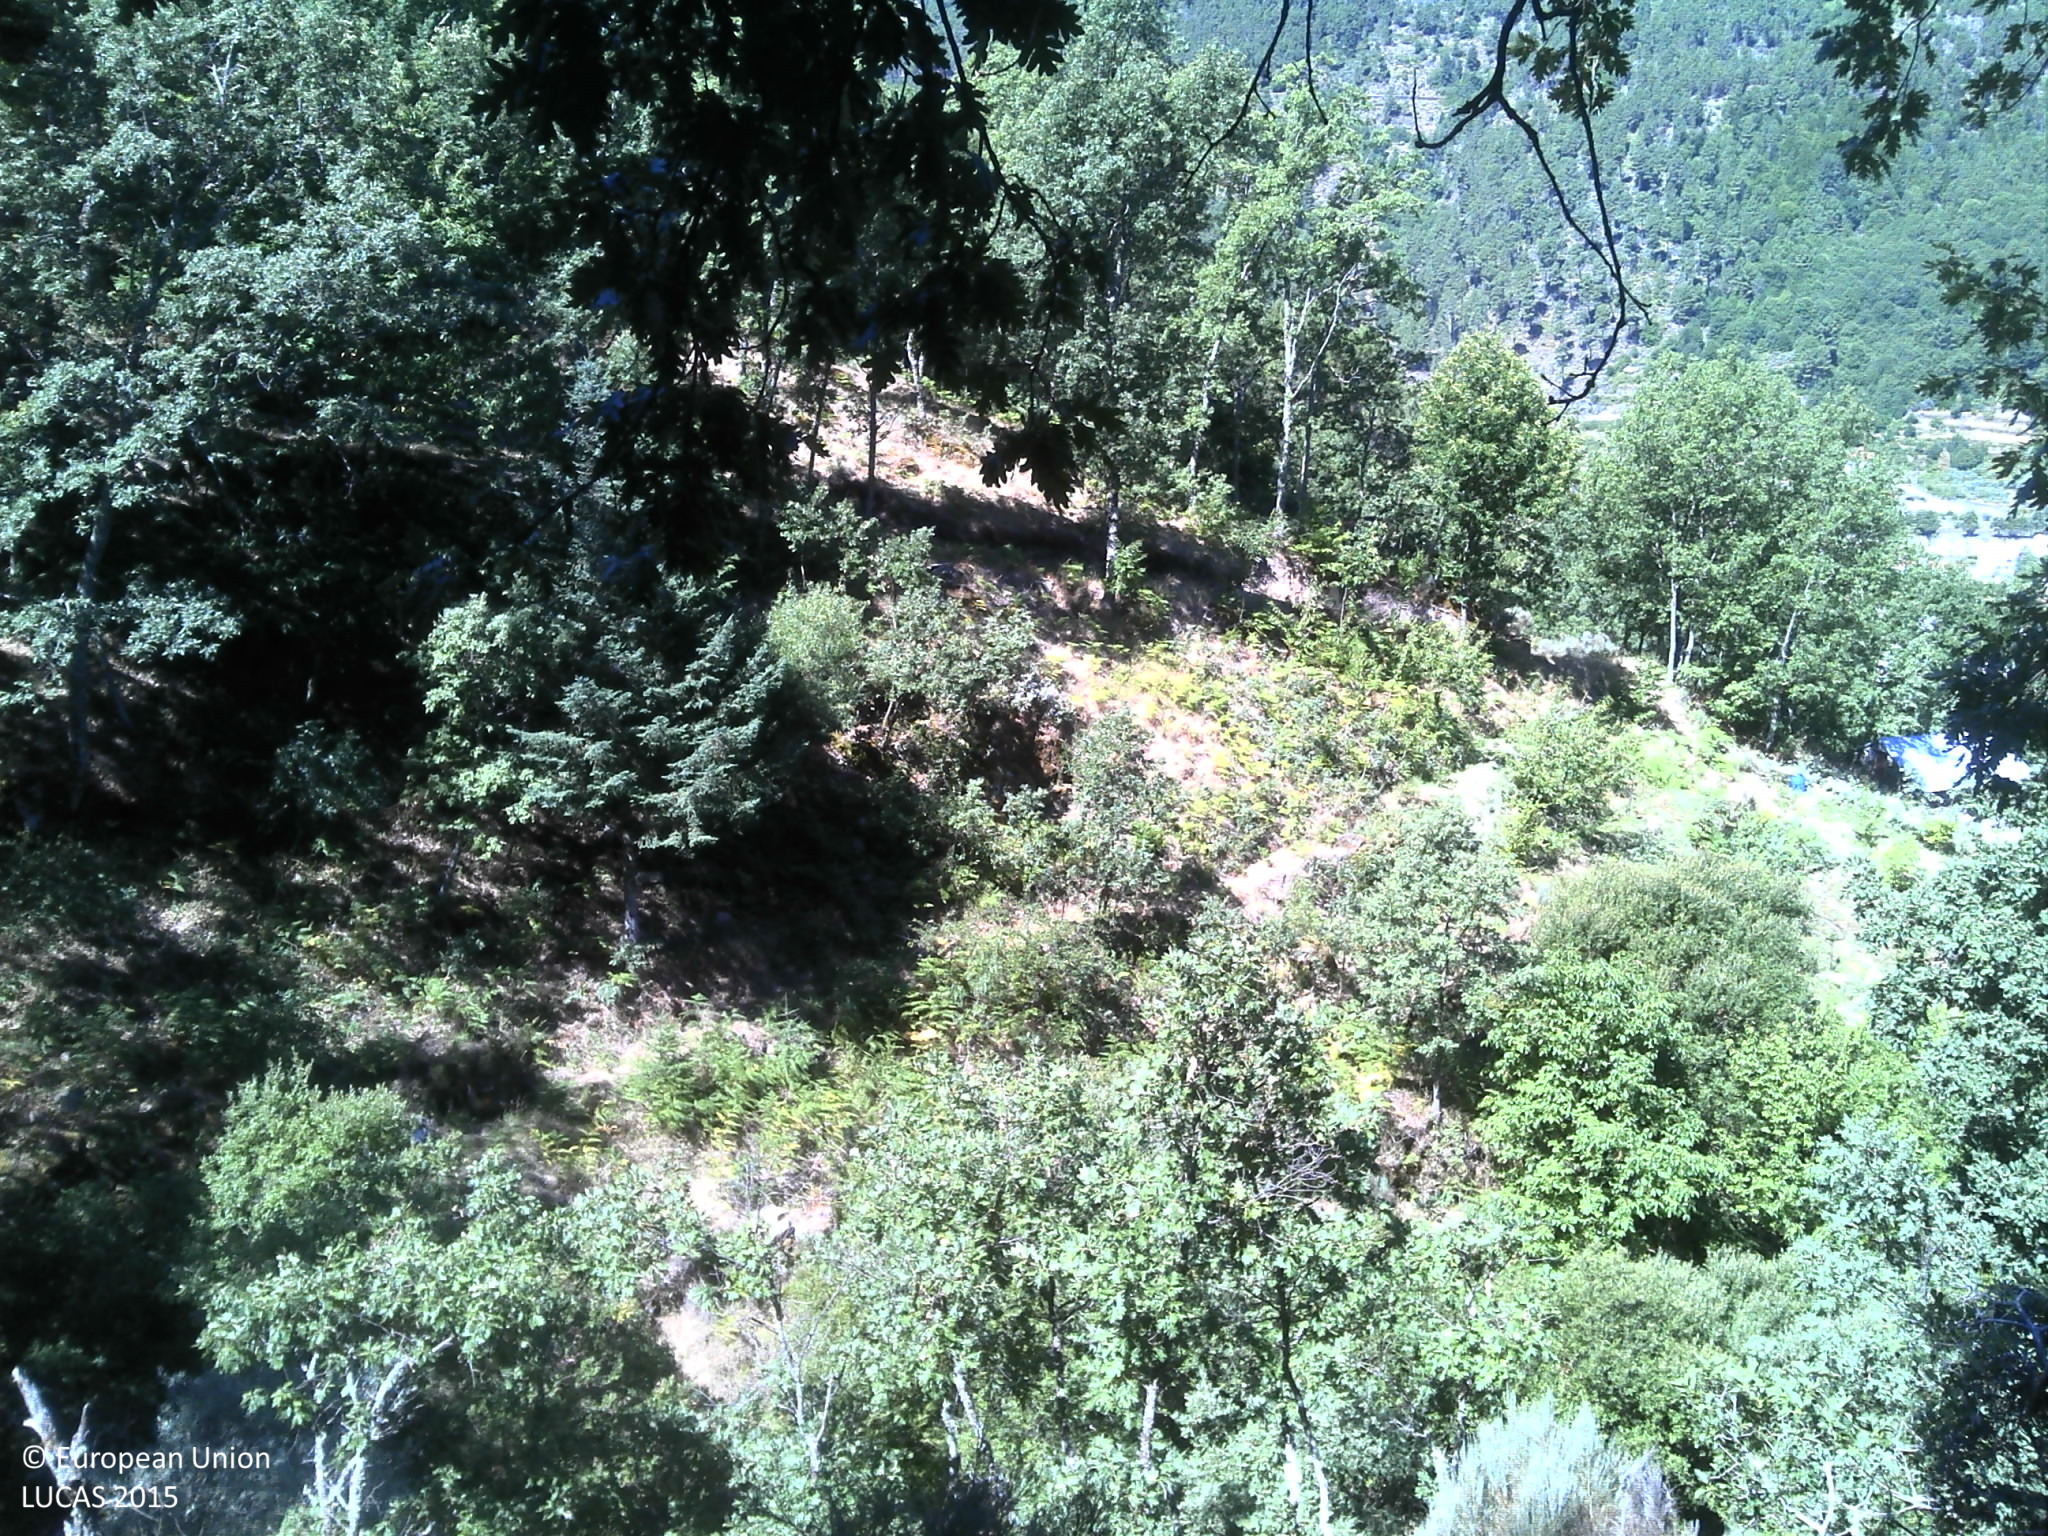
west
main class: Shrubland
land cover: Shrubland with sparse tree cover
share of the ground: 50 - 75 %
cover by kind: shrubs 70 %, herbaceous plants 10 %, unconsolidated bare surface 10 %, broadleaved forest trees 5 %
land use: Abandoned areas
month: July
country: PT
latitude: 40.3910
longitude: -7.5337
